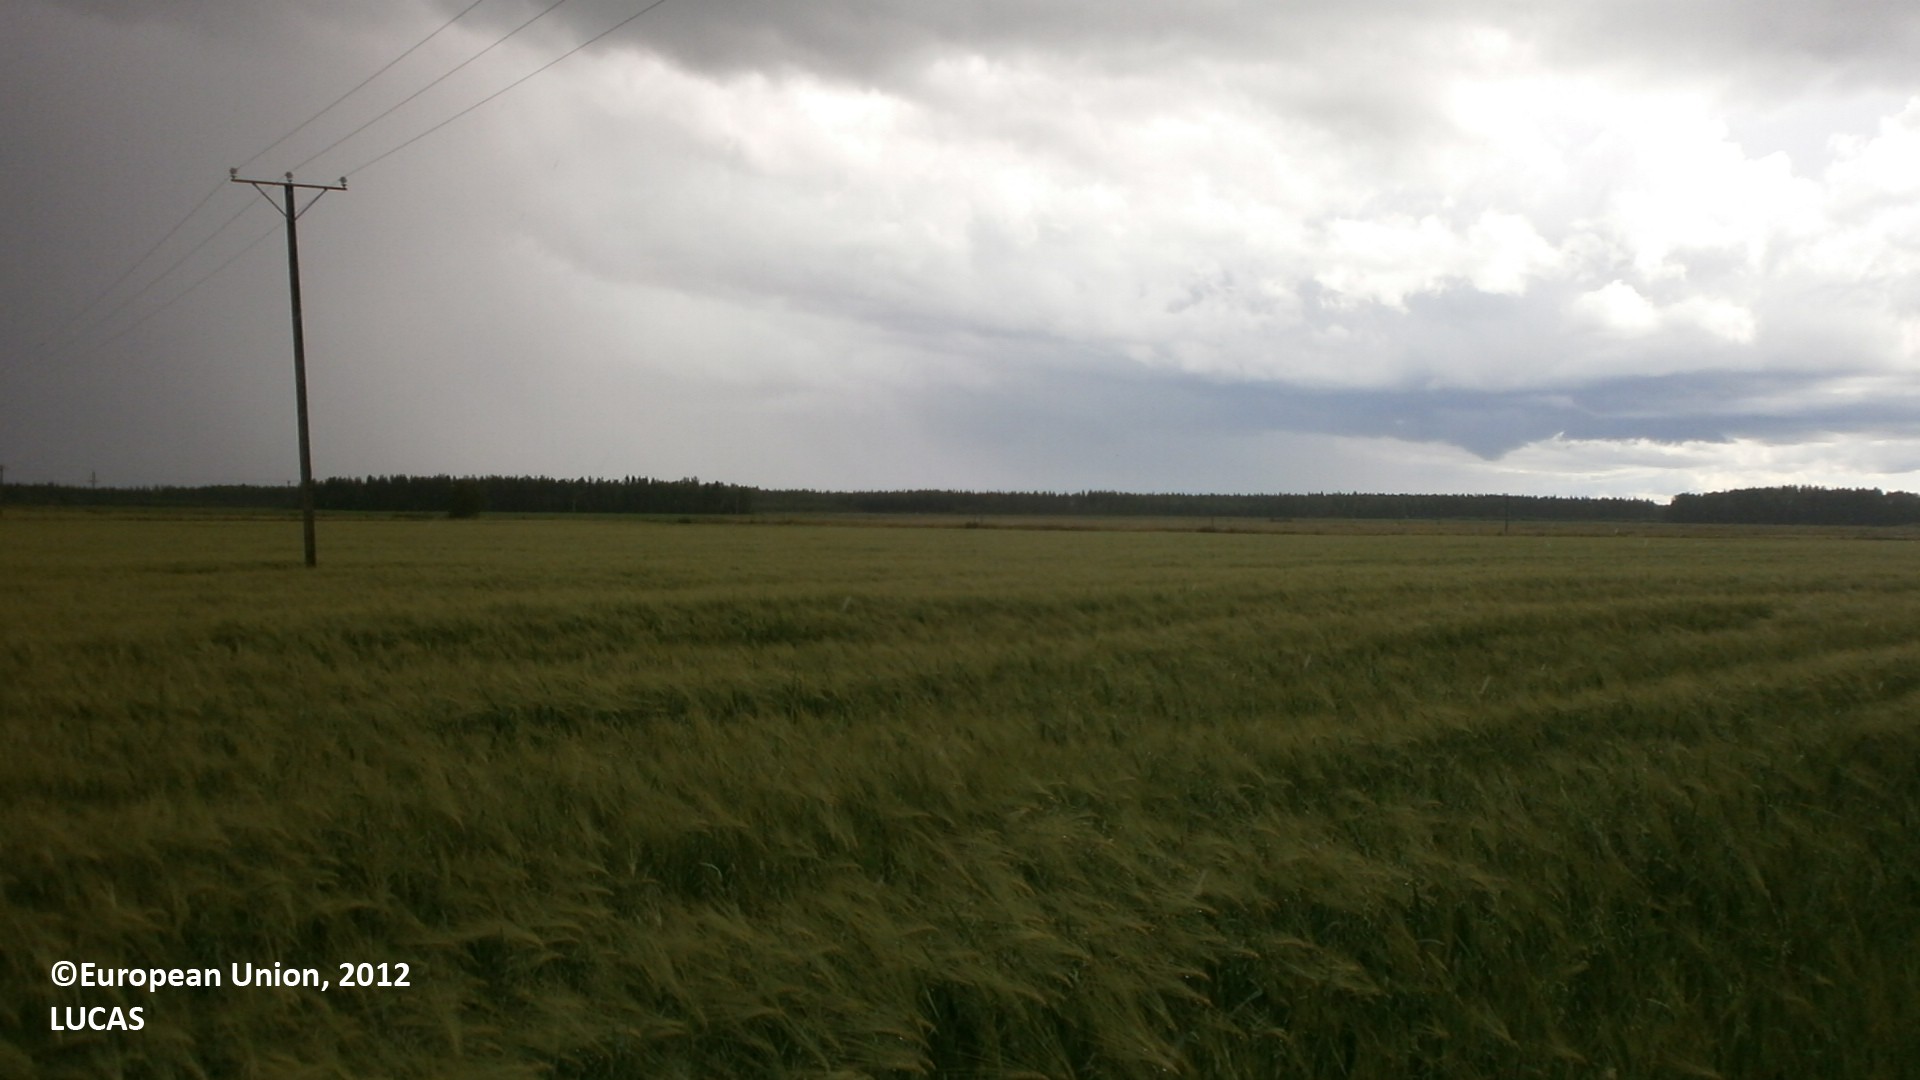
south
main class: Cropland
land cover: Barley
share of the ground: 50 - 75 %
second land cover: Oats
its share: 50 - 75 %
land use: Agriculture (excluding fallow land and kitchen gardens)
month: July
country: FI
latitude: 63.9174
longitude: 24.2387
